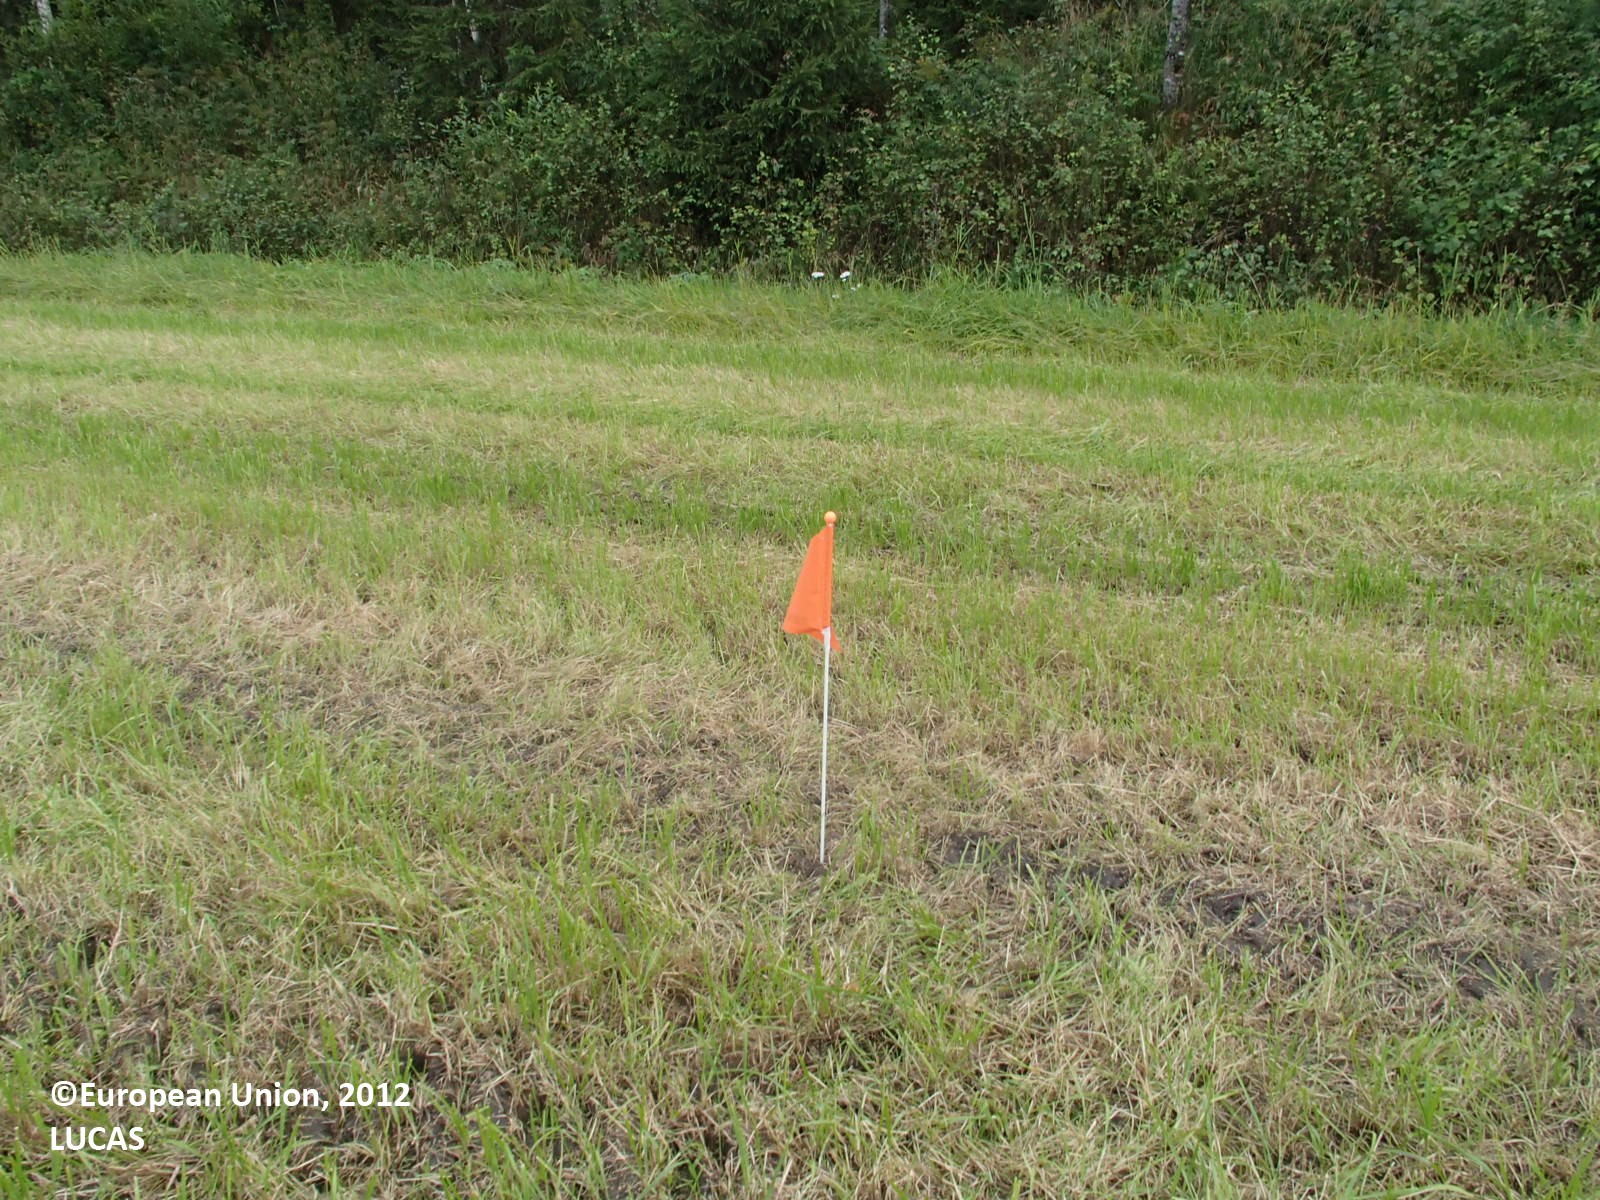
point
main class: Cropland
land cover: Temporary grasslands
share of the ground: > 75 %
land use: Agriculture (excluding fallow land and kitchen gardens)
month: August
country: FI
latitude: 63.3959
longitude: 27.9656
